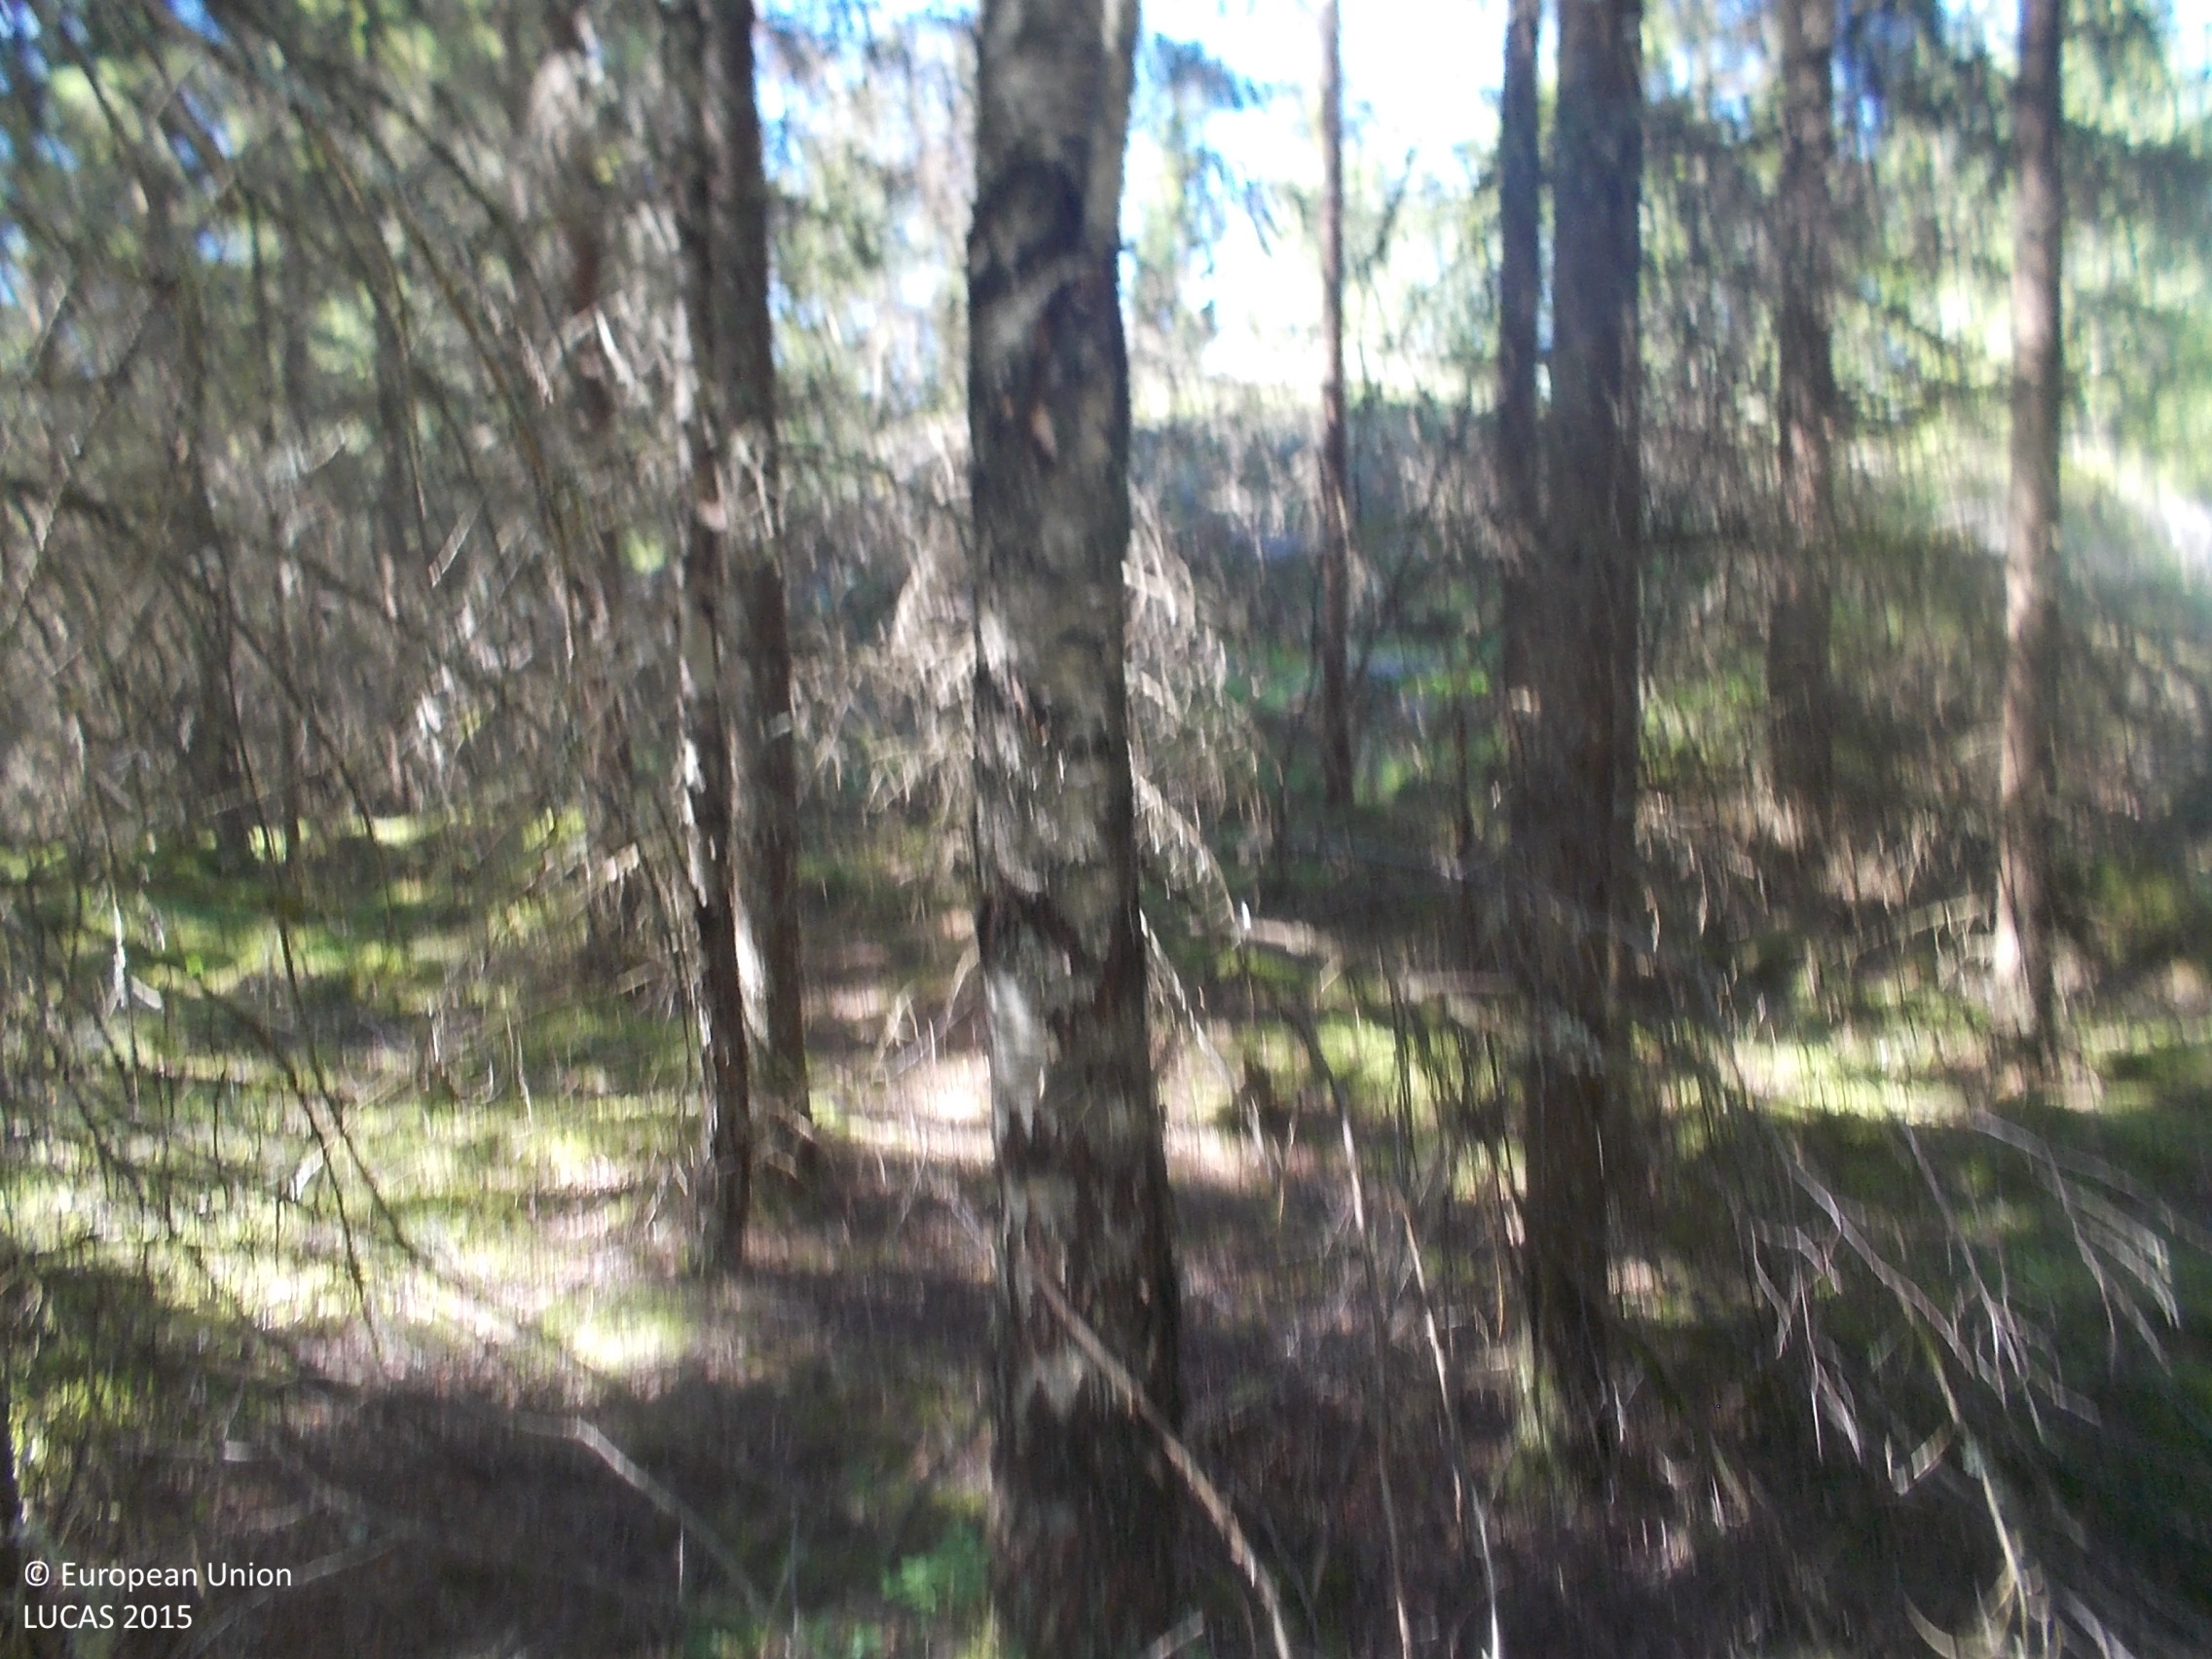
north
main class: Woodland
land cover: Spruce dominated coniferous woodland
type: boreal forest
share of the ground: > 75 %
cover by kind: coniferous forest trees 75 %, lichens and mosses 15 %, unconsolidated bare surface 10 %
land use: Forestry
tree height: > 5 m
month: July
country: SE
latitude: 57.2995
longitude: 13.1991
